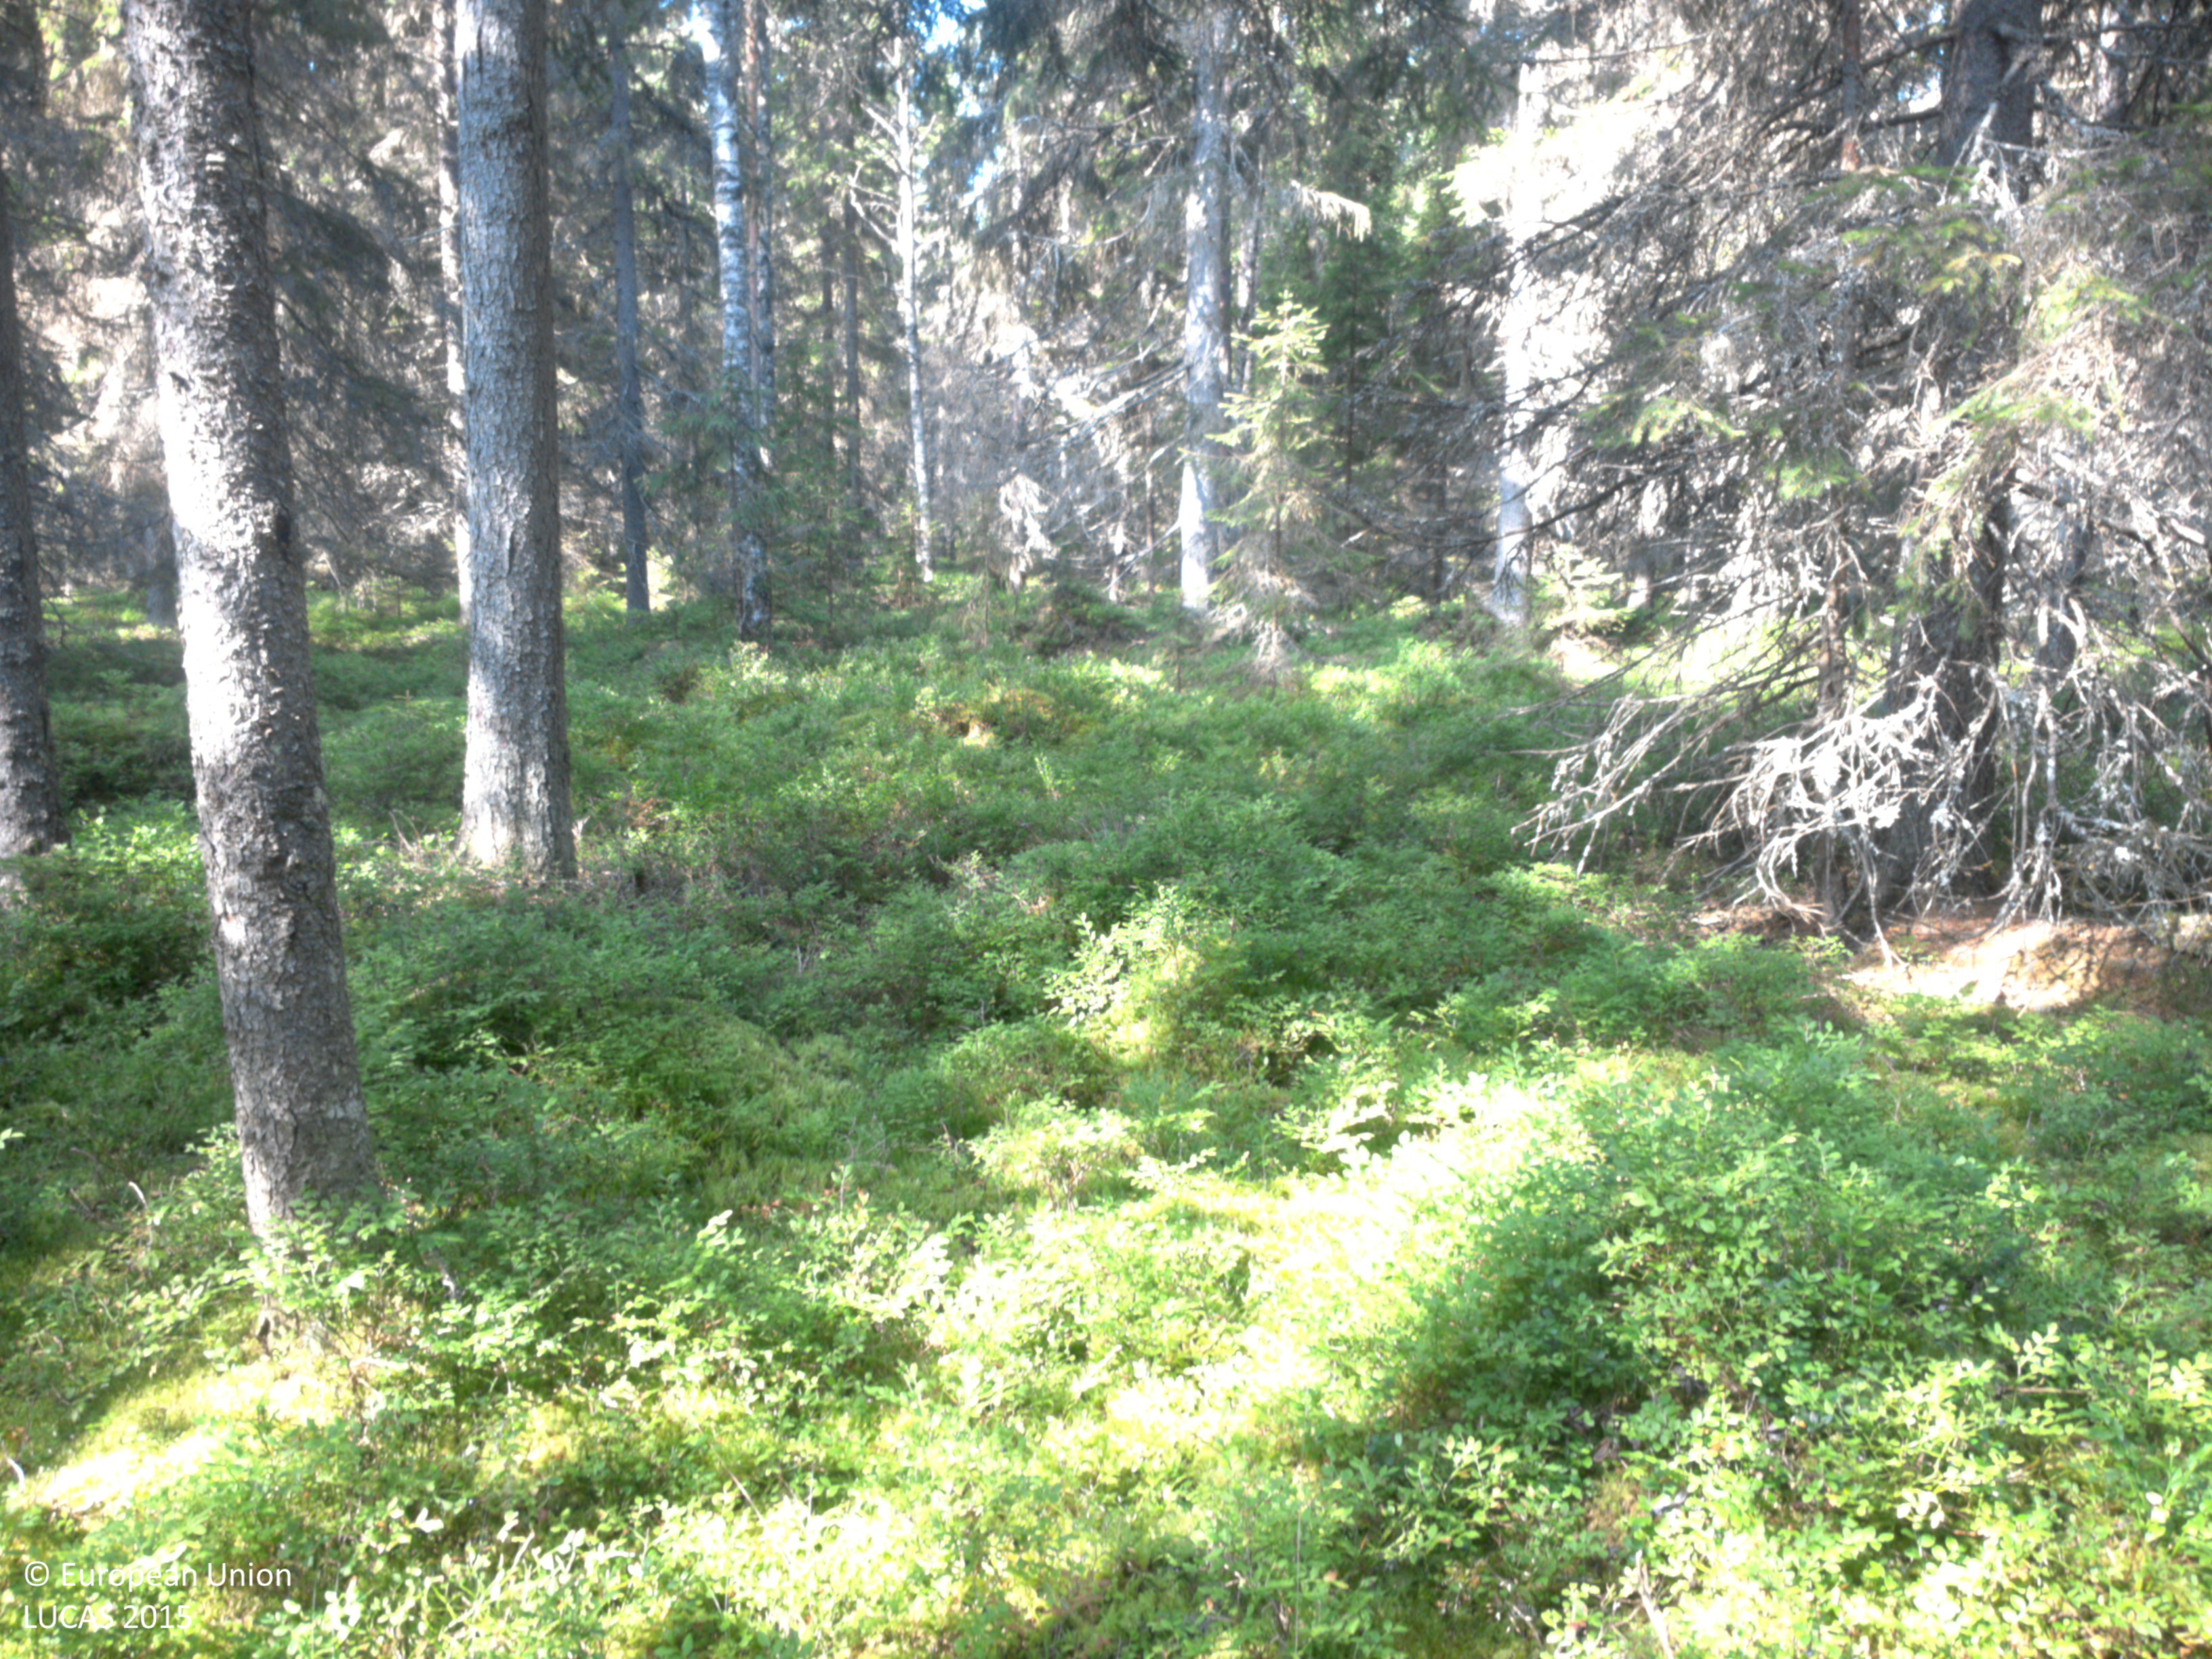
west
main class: Woodland
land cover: Spruce dominated coniferous woodland
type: boreal forest
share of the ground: 50 - 75 %
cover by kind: coniferous forest trees 60 %, shrubs 40 %
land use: Forestry
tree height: > 5 m
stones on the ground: < 10 %
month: August
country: SE
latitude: 63.5057
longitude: 19.6046
